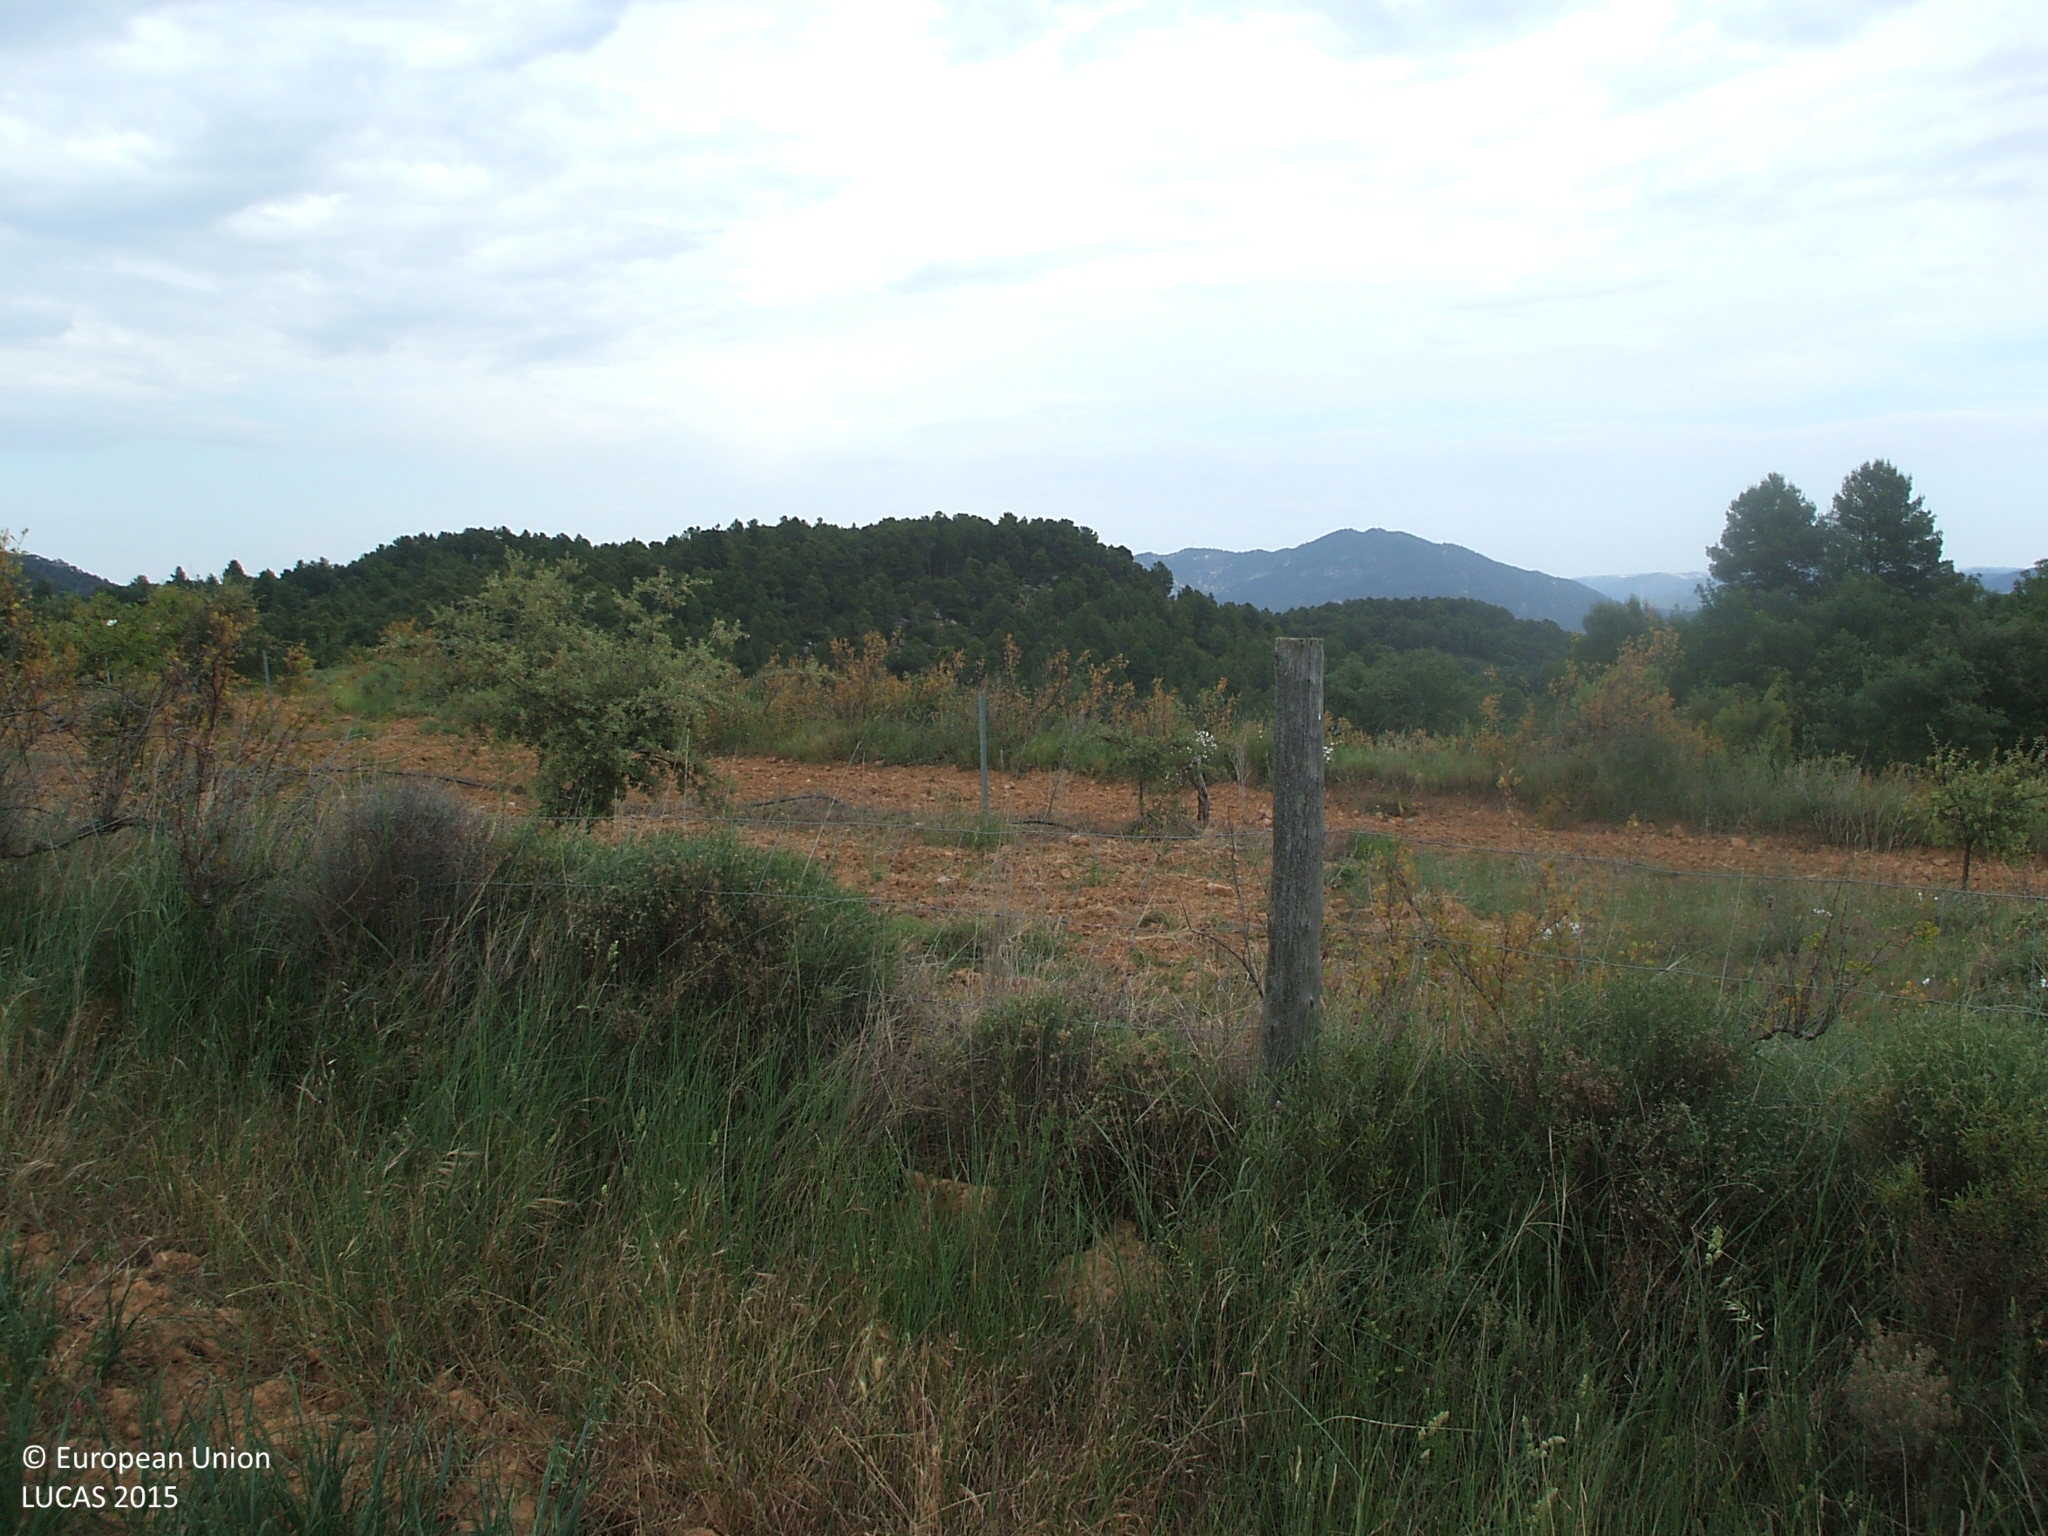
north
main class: Cropland
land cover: Other fresh vegetables
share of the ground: 10 - 25 %
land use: Agriculture (excluding fallow land and kitchen gardens)
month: June
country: ES
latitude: 40.7731
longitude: -0.0198
